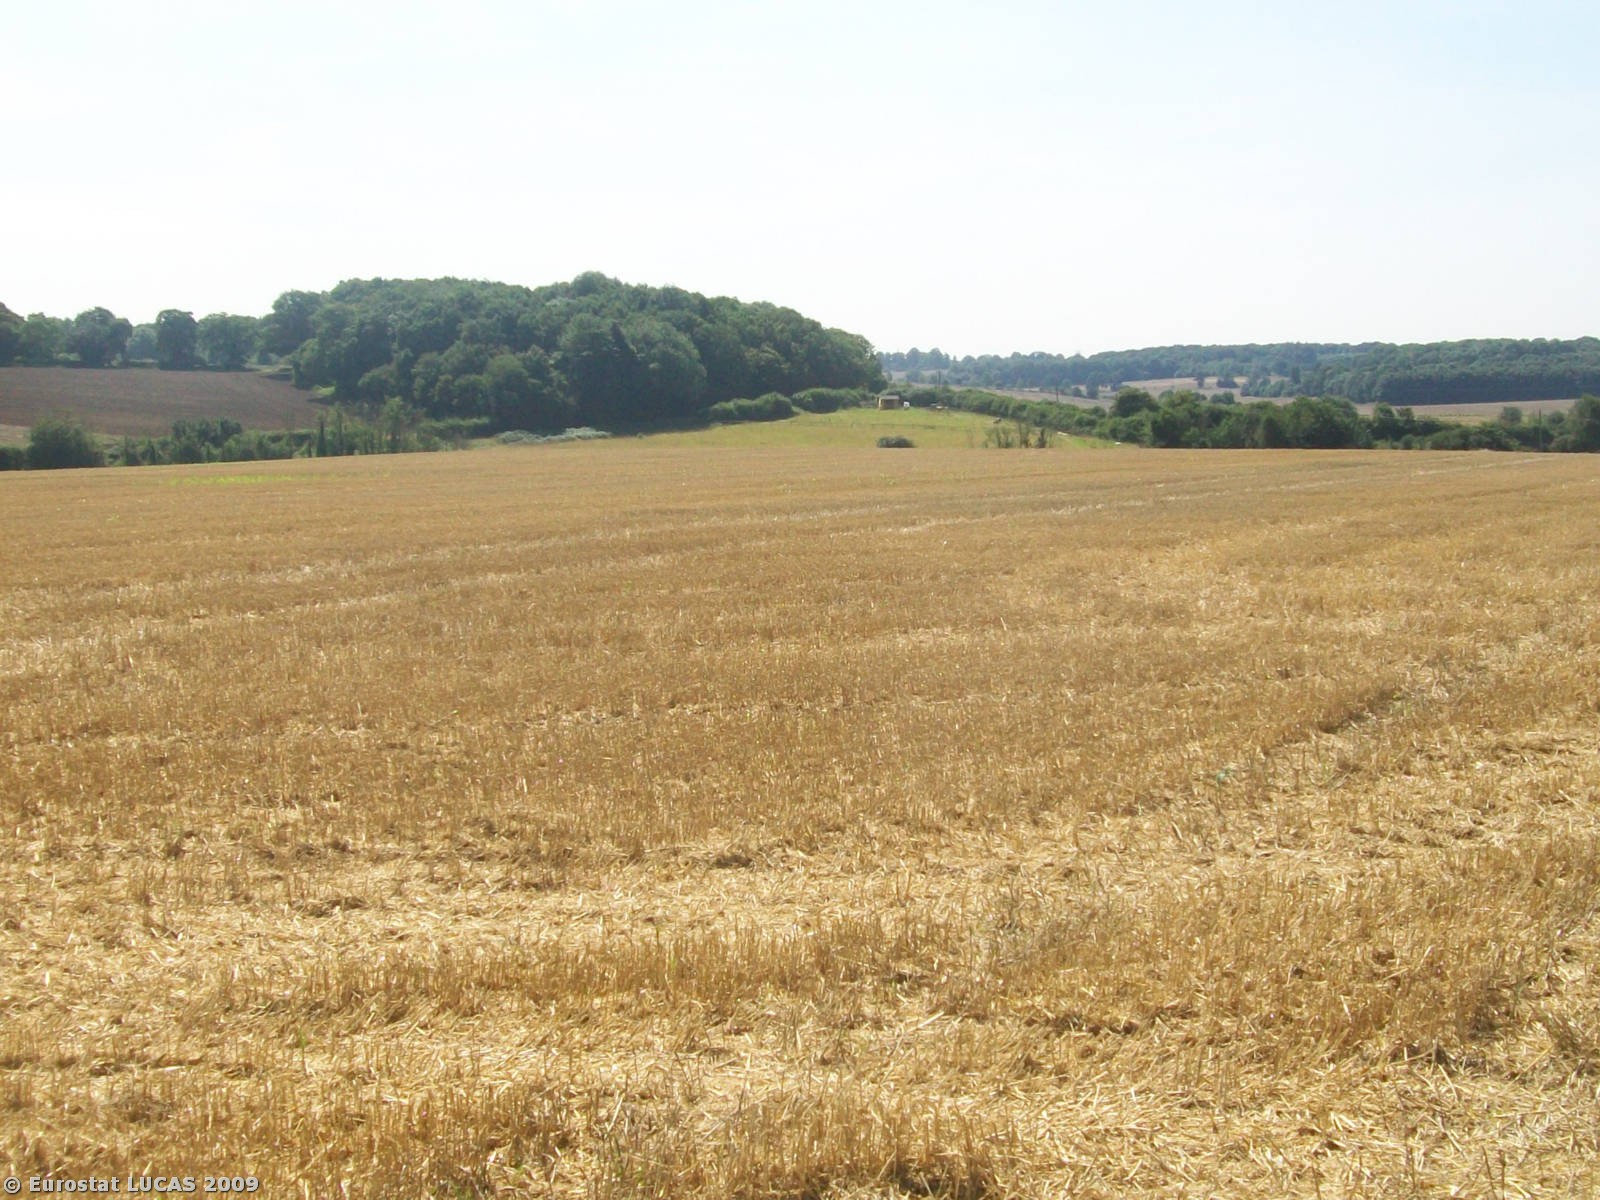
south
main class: Cropland
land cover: Common wheat
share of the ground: < 10 %
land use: Agriculture (excluding fallow land and kitchen gardens)
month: August
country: GB
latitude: 51.9260
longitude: 0.0943
